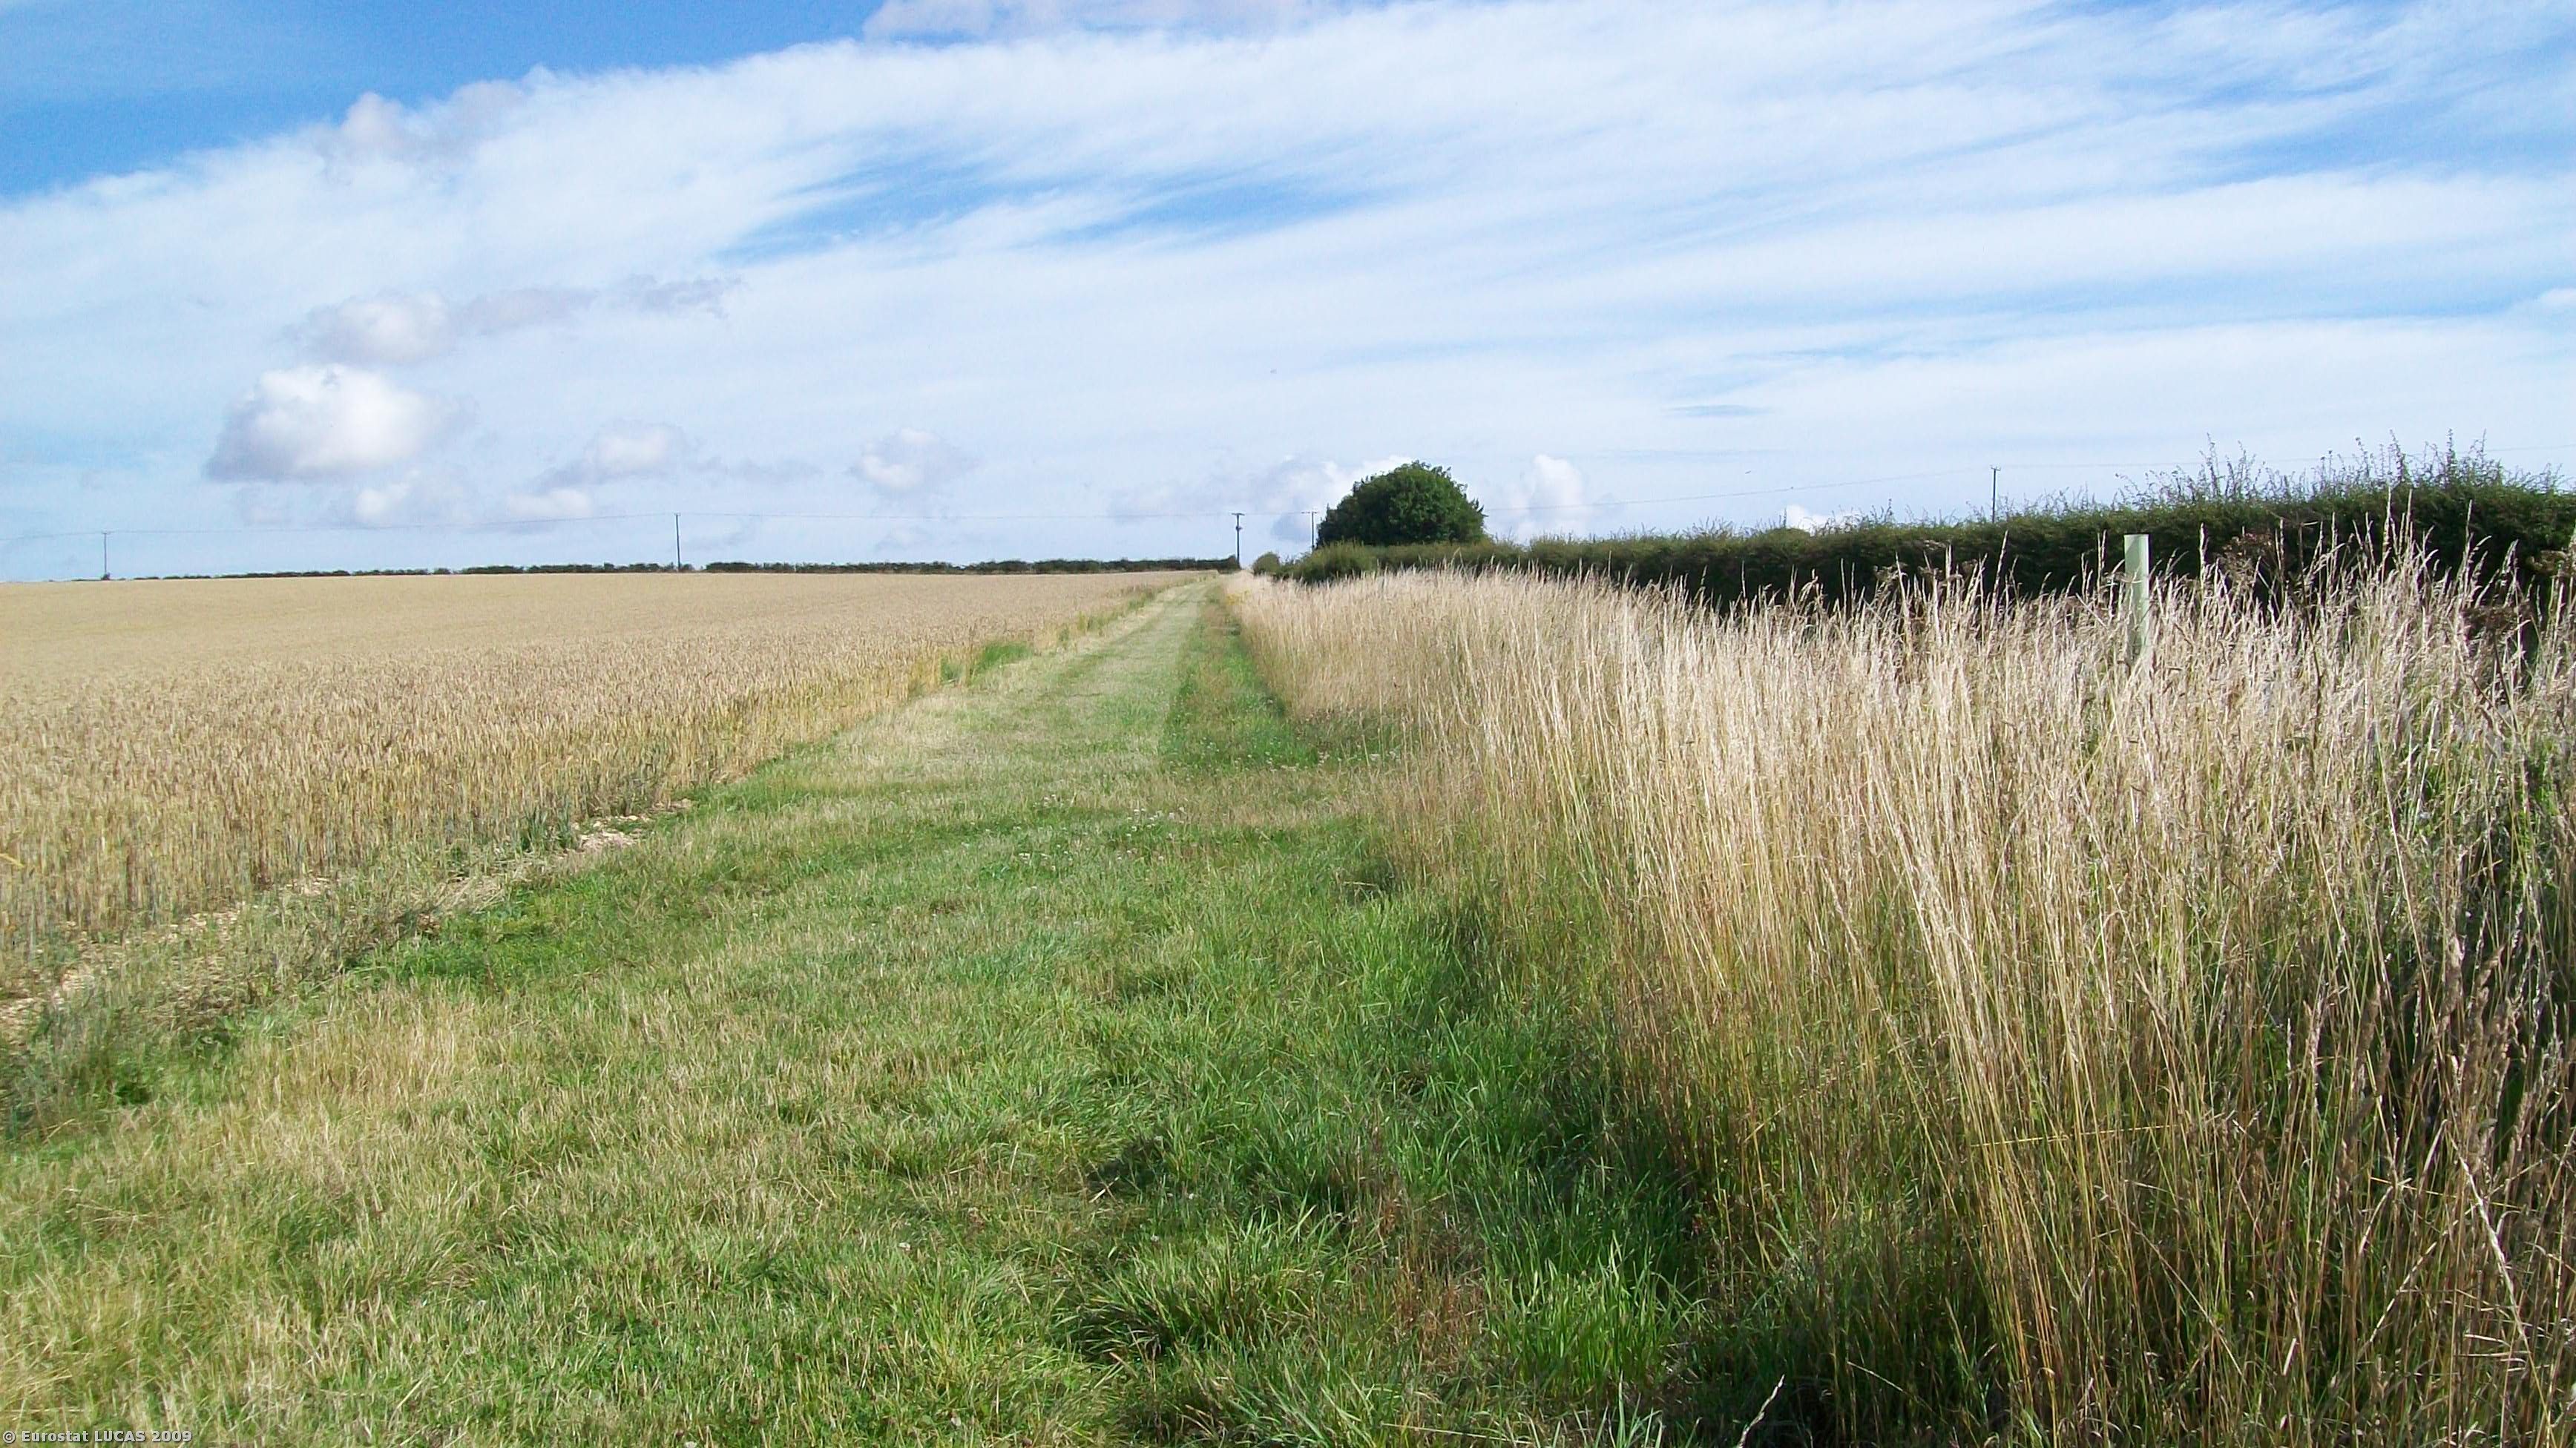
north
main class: Grassland
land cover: Grassland without tree/shrub cover
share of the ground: > 75 %
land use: Agriculture (excluding fallow land and kitchen gardens)
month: July
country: GB
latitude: 54.0761
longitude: -0.4129
